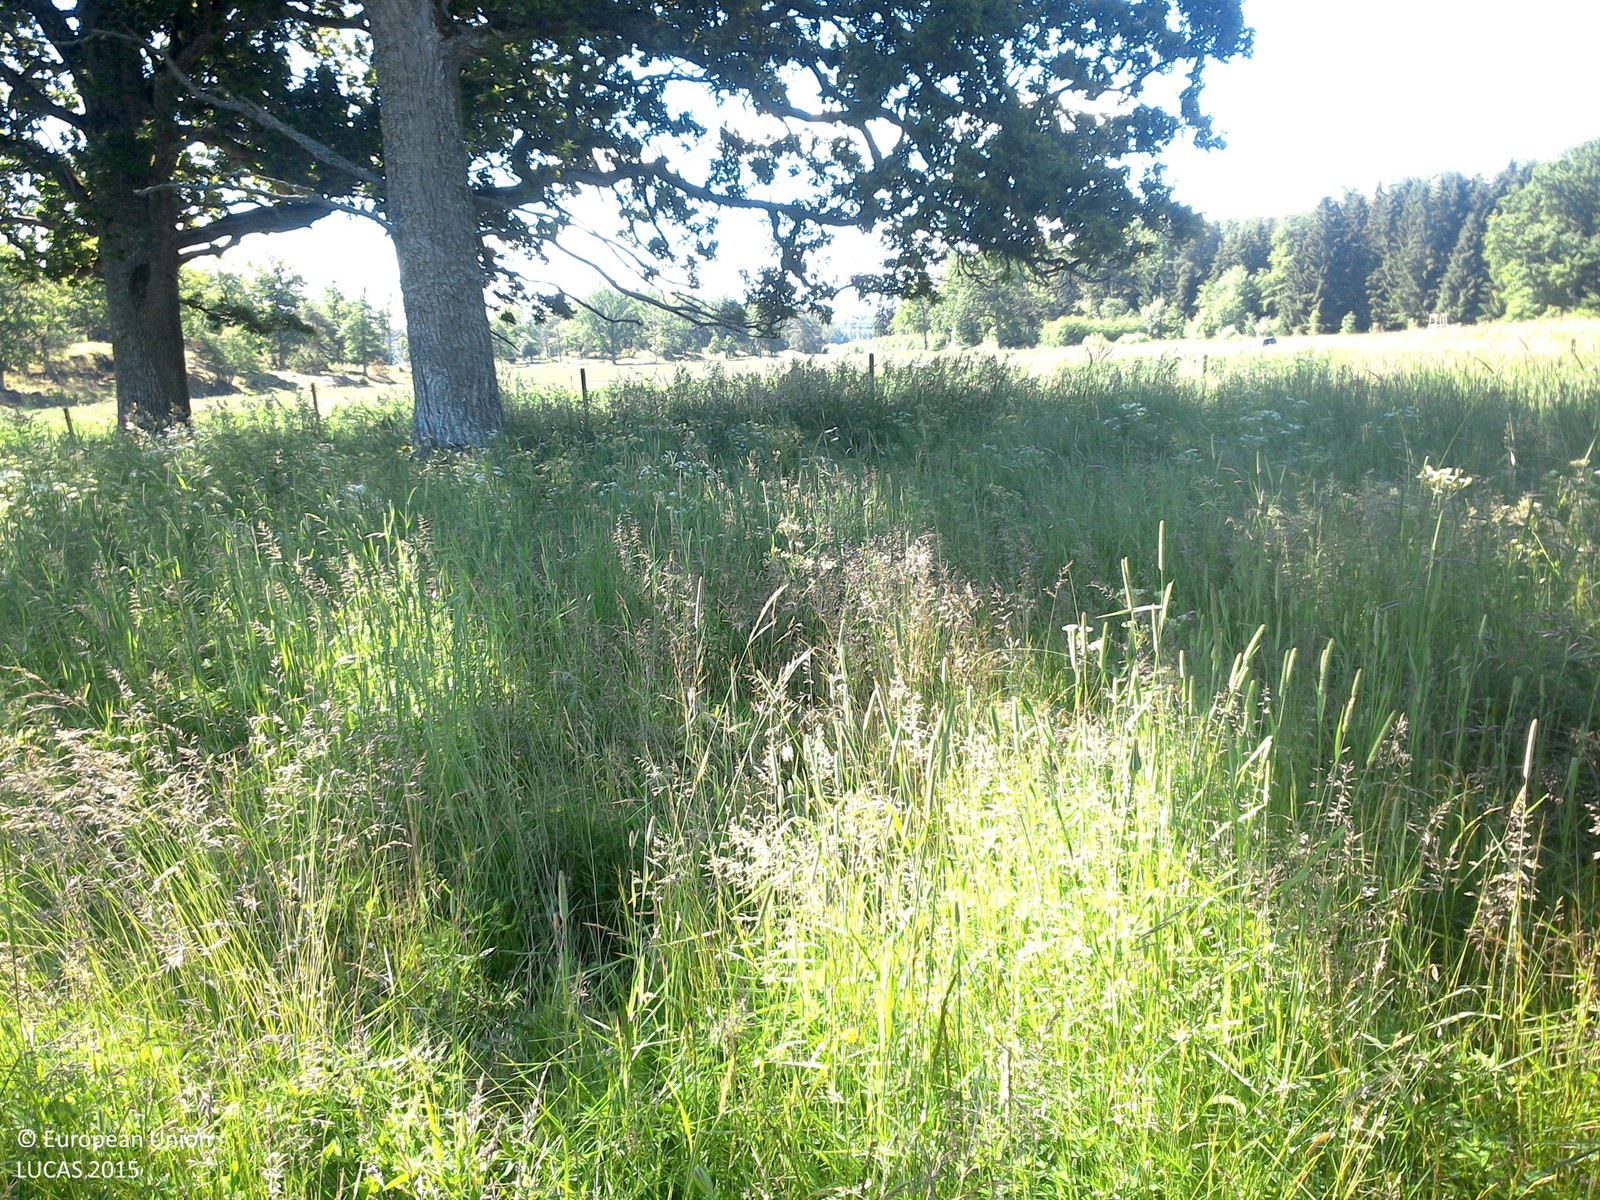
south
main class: Grassland
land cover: Grassland with sparse tree/shrub cover
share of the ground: > 75 %
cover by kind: herbaceous plants 95 %, broadleaved forest trees 5 %
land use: Agriculture (excluding fallow land and kitchen gardens)
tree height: > 5 m
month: July
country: SE
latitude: 58.4016
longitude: 15.3501
